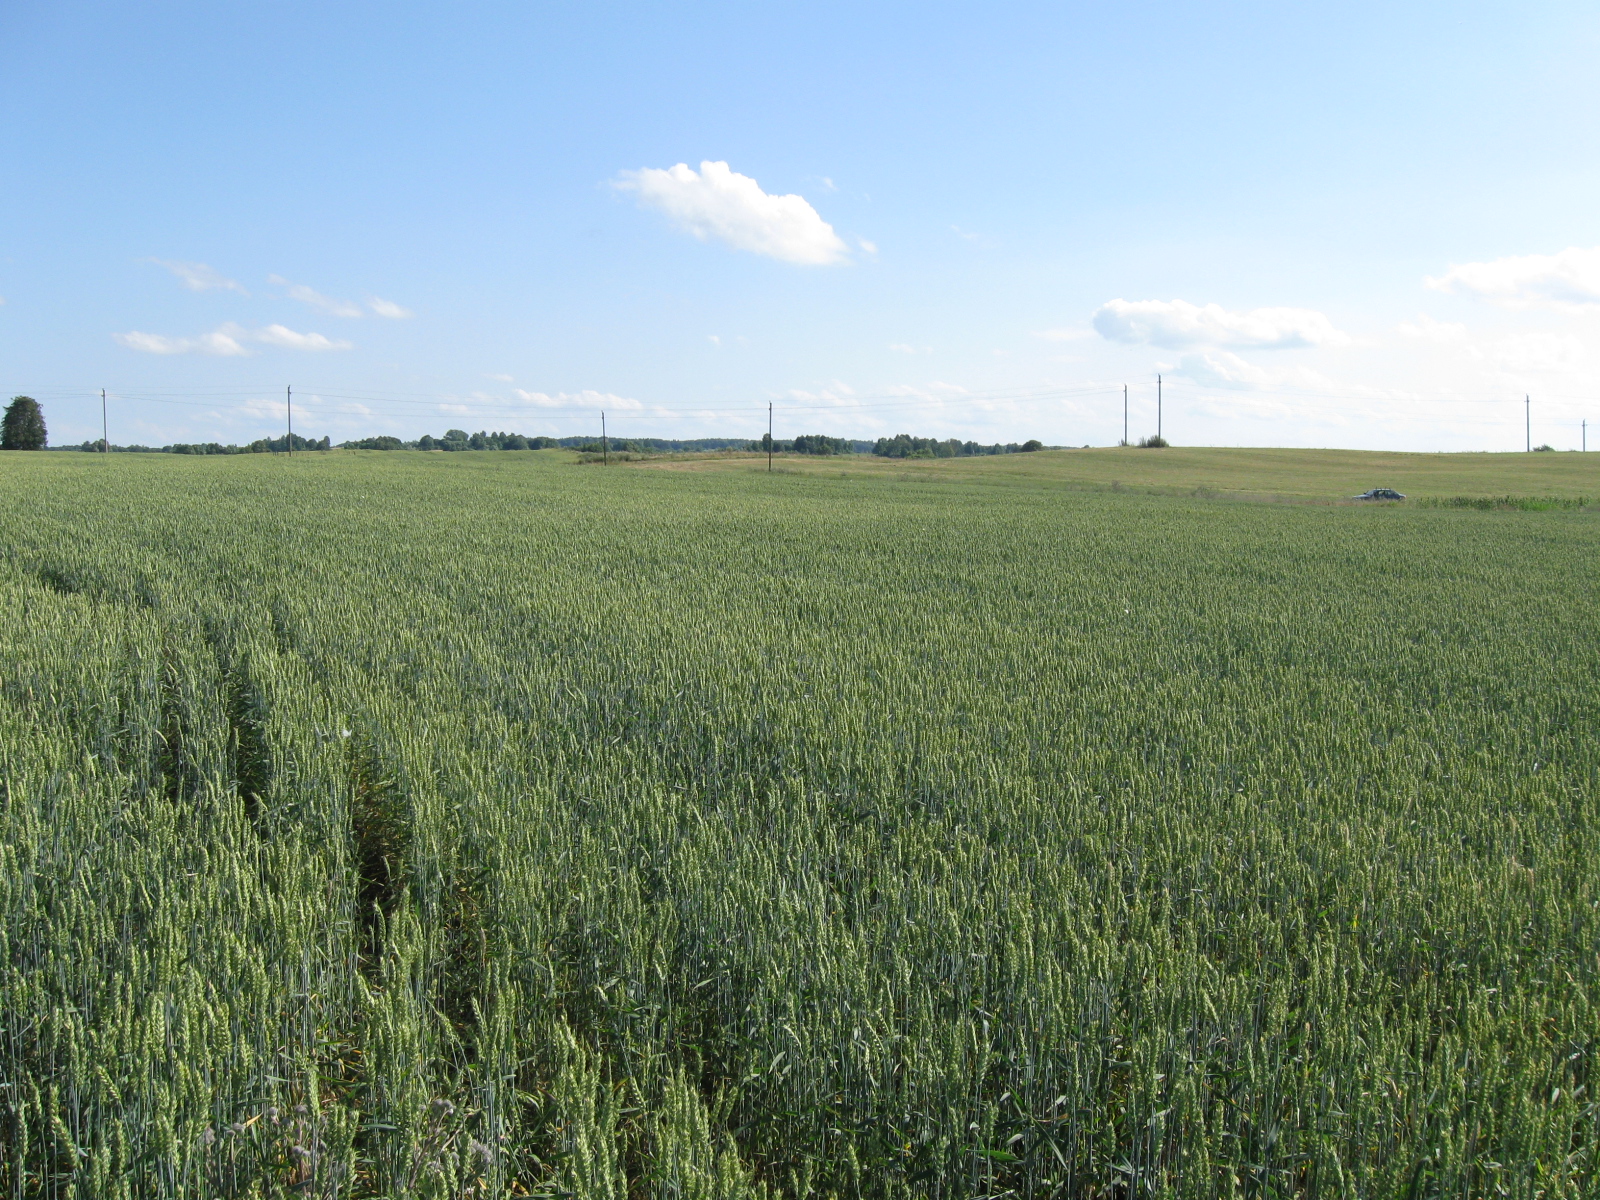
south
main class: Cropland
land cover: Common wheat
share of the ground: > 75 %
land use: Agriculture (excluding fallow land and kitchen gardens)
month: July
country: LT
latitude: 54.3295
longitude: 23.4128
